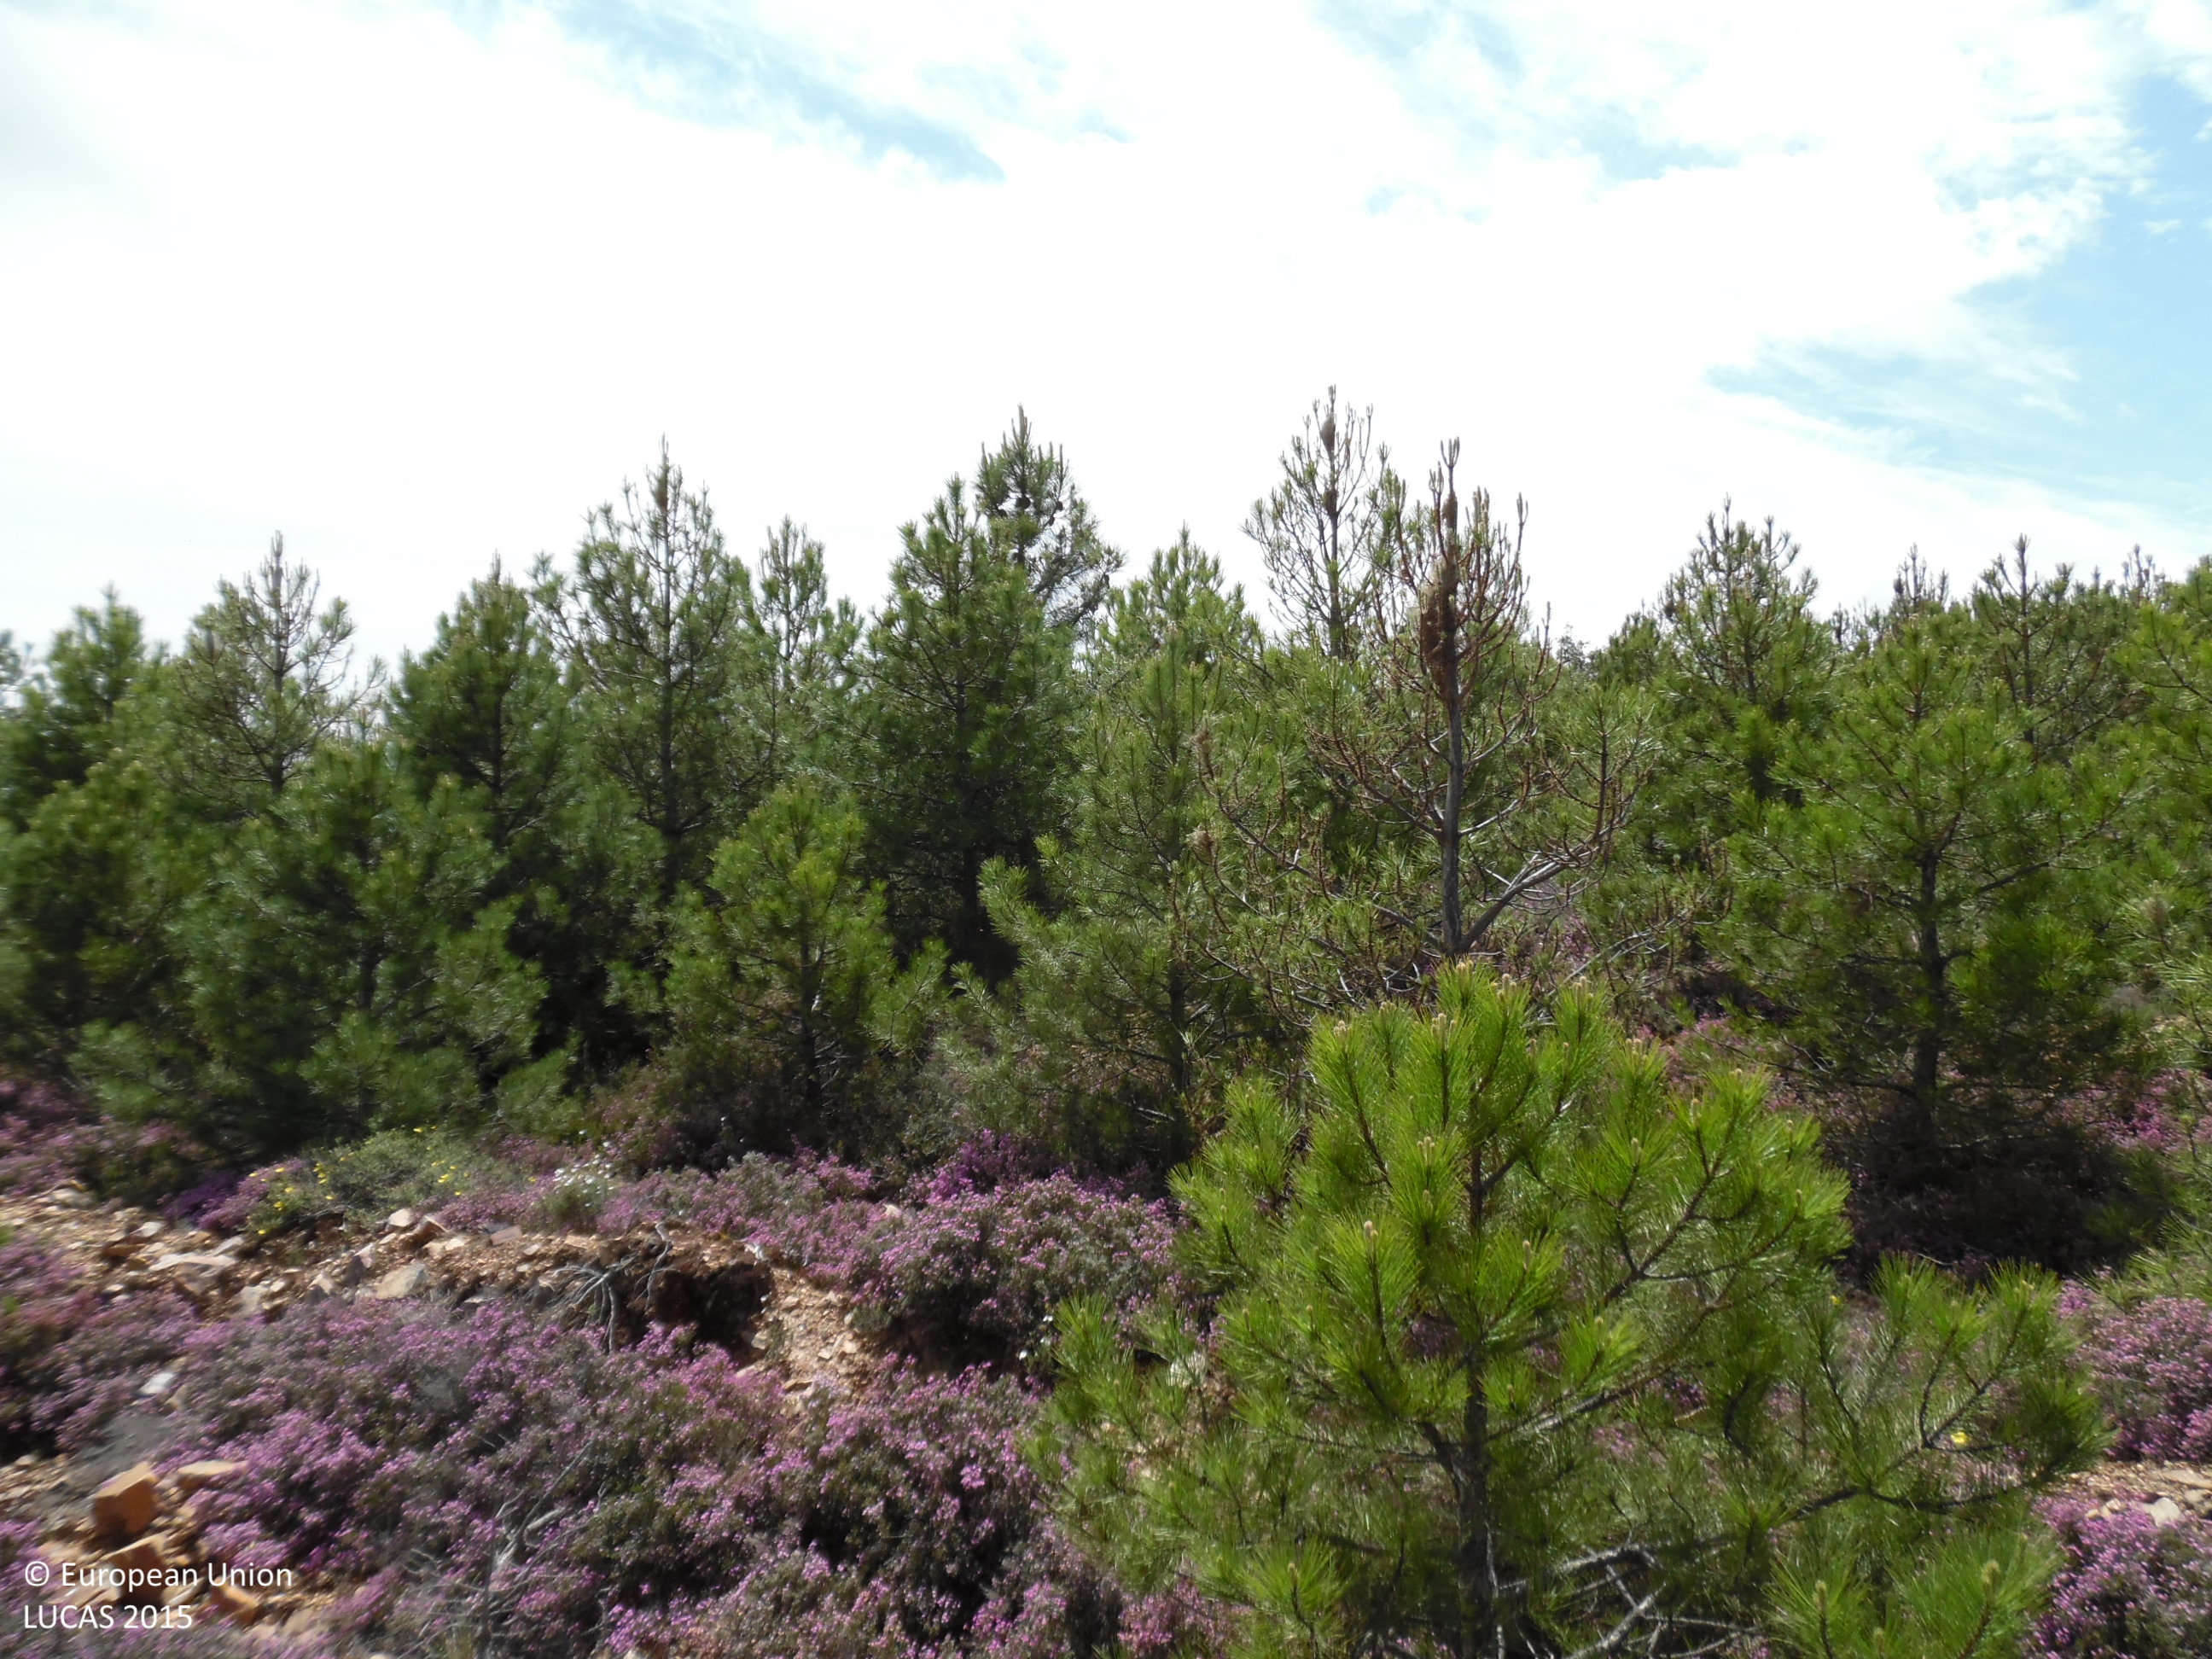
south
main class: Woodland
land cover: Pine dominated coniferous woodland
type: coniferous forest of the mediterranean region
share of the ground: > 75 %
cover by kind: coniferous forest trees 90 %, shrubs 10 %
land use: Forestry
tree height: > 5 m
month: May
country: ES
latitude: 42.4982
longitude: -6.0838
